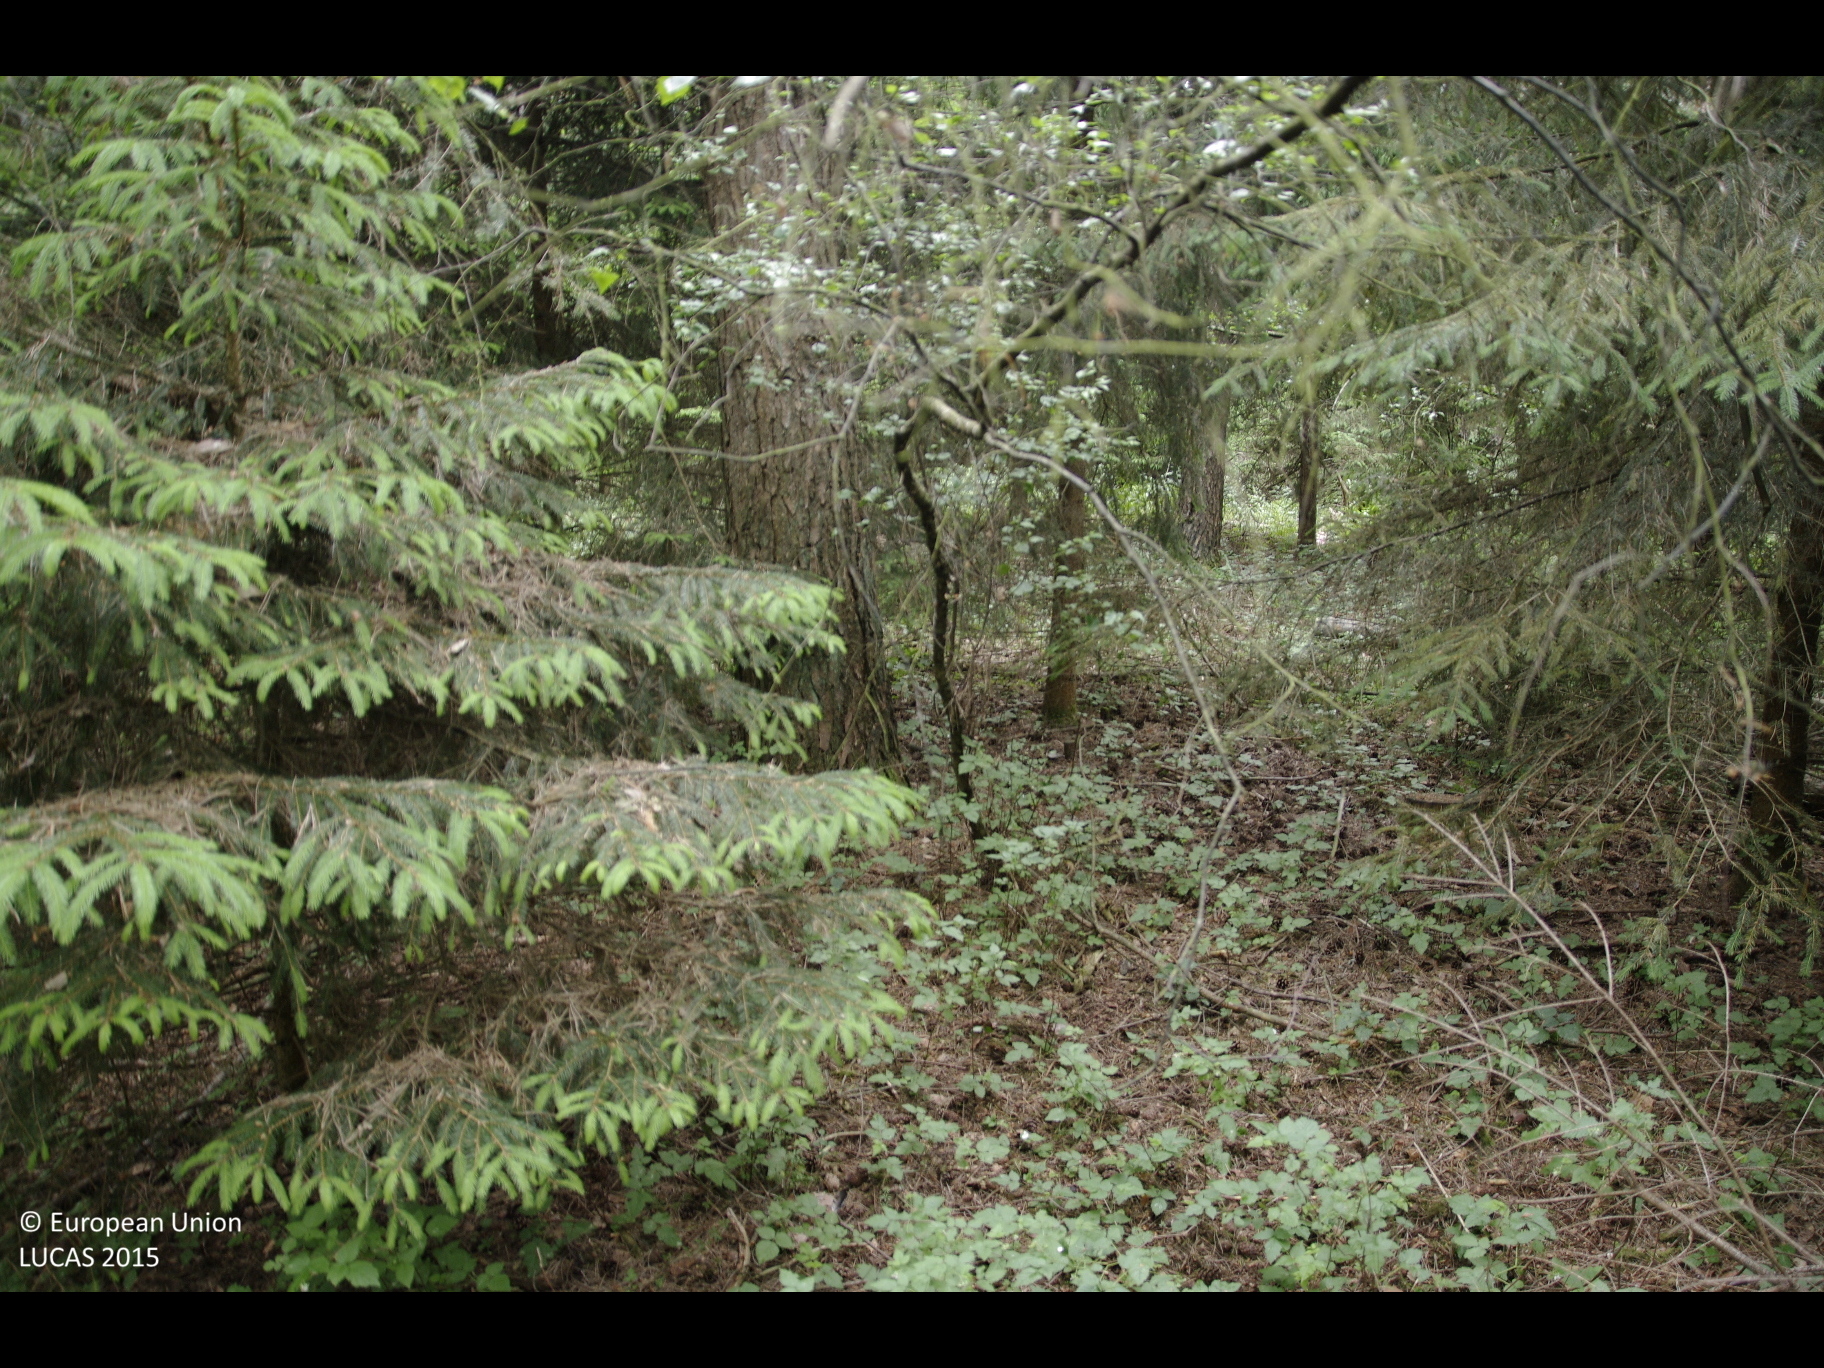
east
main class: Woodland
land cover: Other coniferous woodland
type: hemiboreal forest and nemoral coniferous forest and mixed broadleaved-coniferous forest
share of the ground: 50 - 75 %
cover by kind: coniferous forest trees 60 %, shrubs 10 %, herbaceous plants 10 %, unconsolidated bare surface 10 %, broadleaved forest trees 5 %, lichens and mosses 5 %
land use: Forestry
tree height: > 5 m
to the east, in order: Other coniferous woodland; Tracks; Spruce dominated mixed woodland; Spruce dominated coniferous woodland; Pine dominated mixed woodland
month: June
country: DE
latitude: 53.1679
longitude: 10.3140
